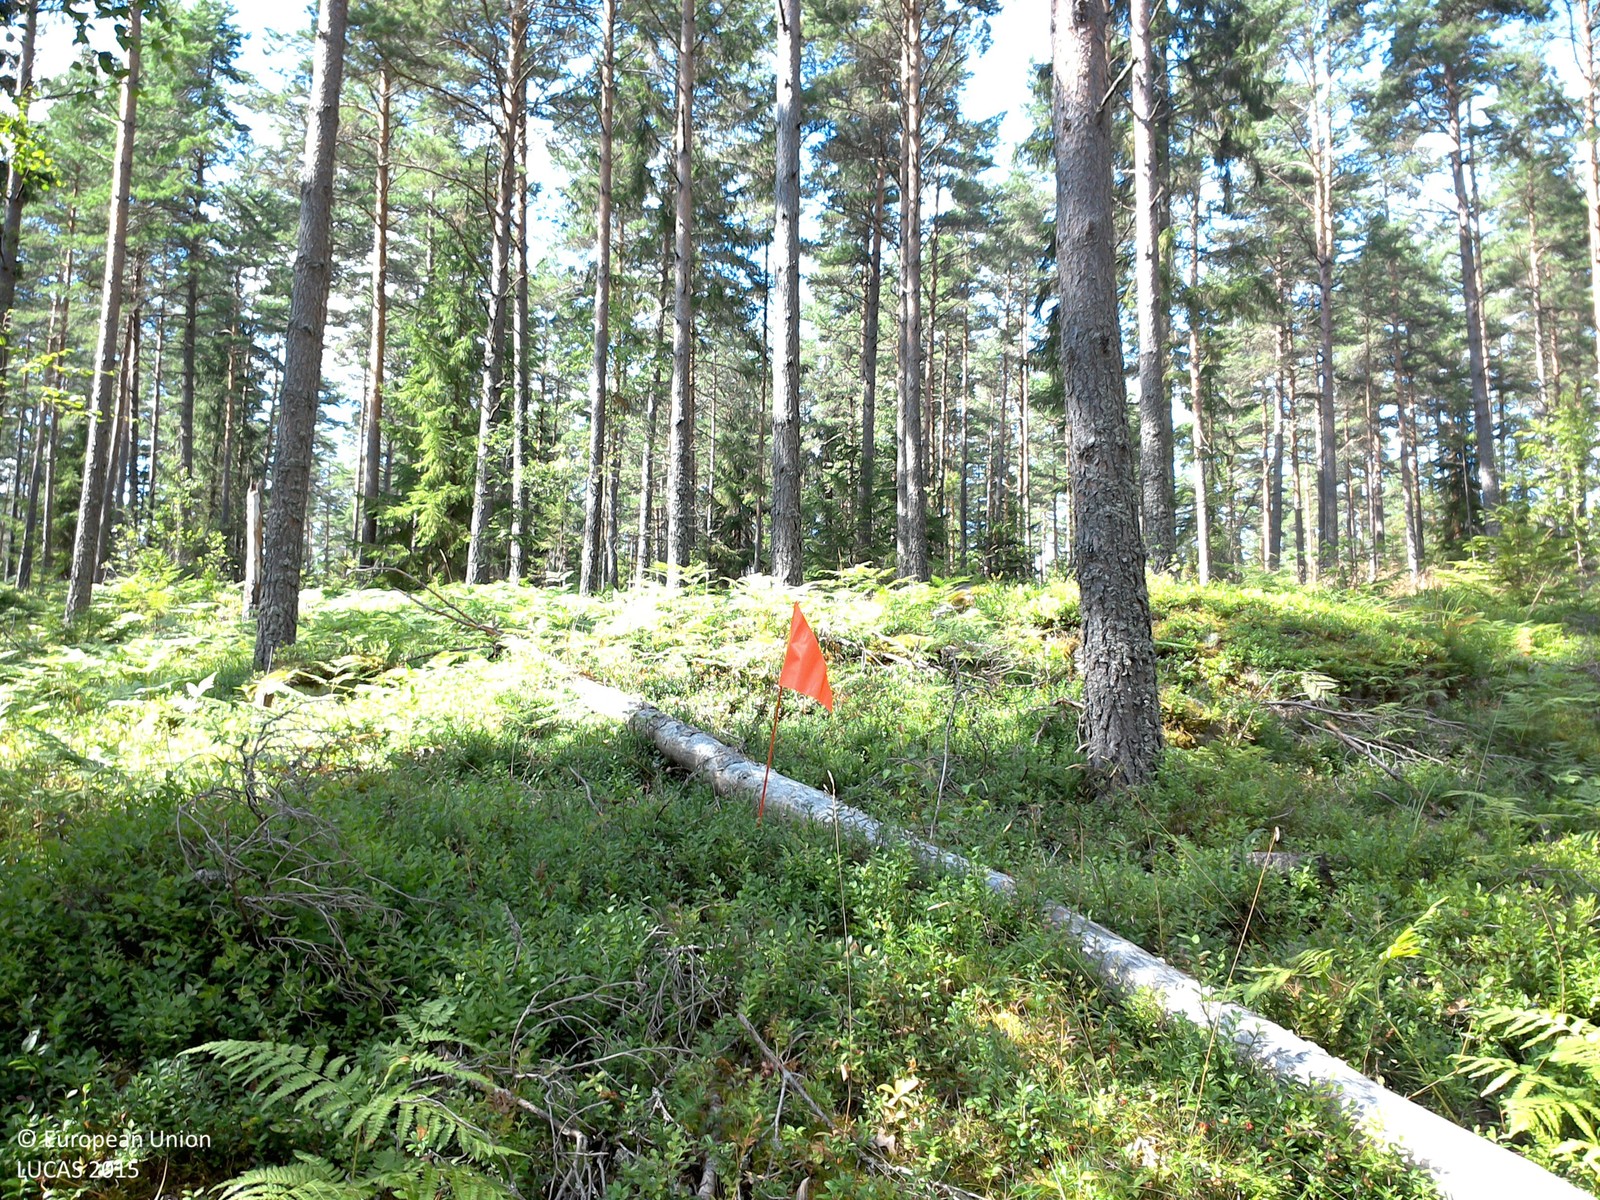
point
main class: Woodland
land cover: Pine dominated coniferous woodland
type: boreal forest
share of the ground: 25 - 50 %
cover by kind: herbaceous plants 65 %, coniferous forest trees 25 %, lichens and mosses 10 %
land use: Forestry
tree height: > 5 m
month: August
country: SE
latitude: 58.1645
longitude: 15.4171
